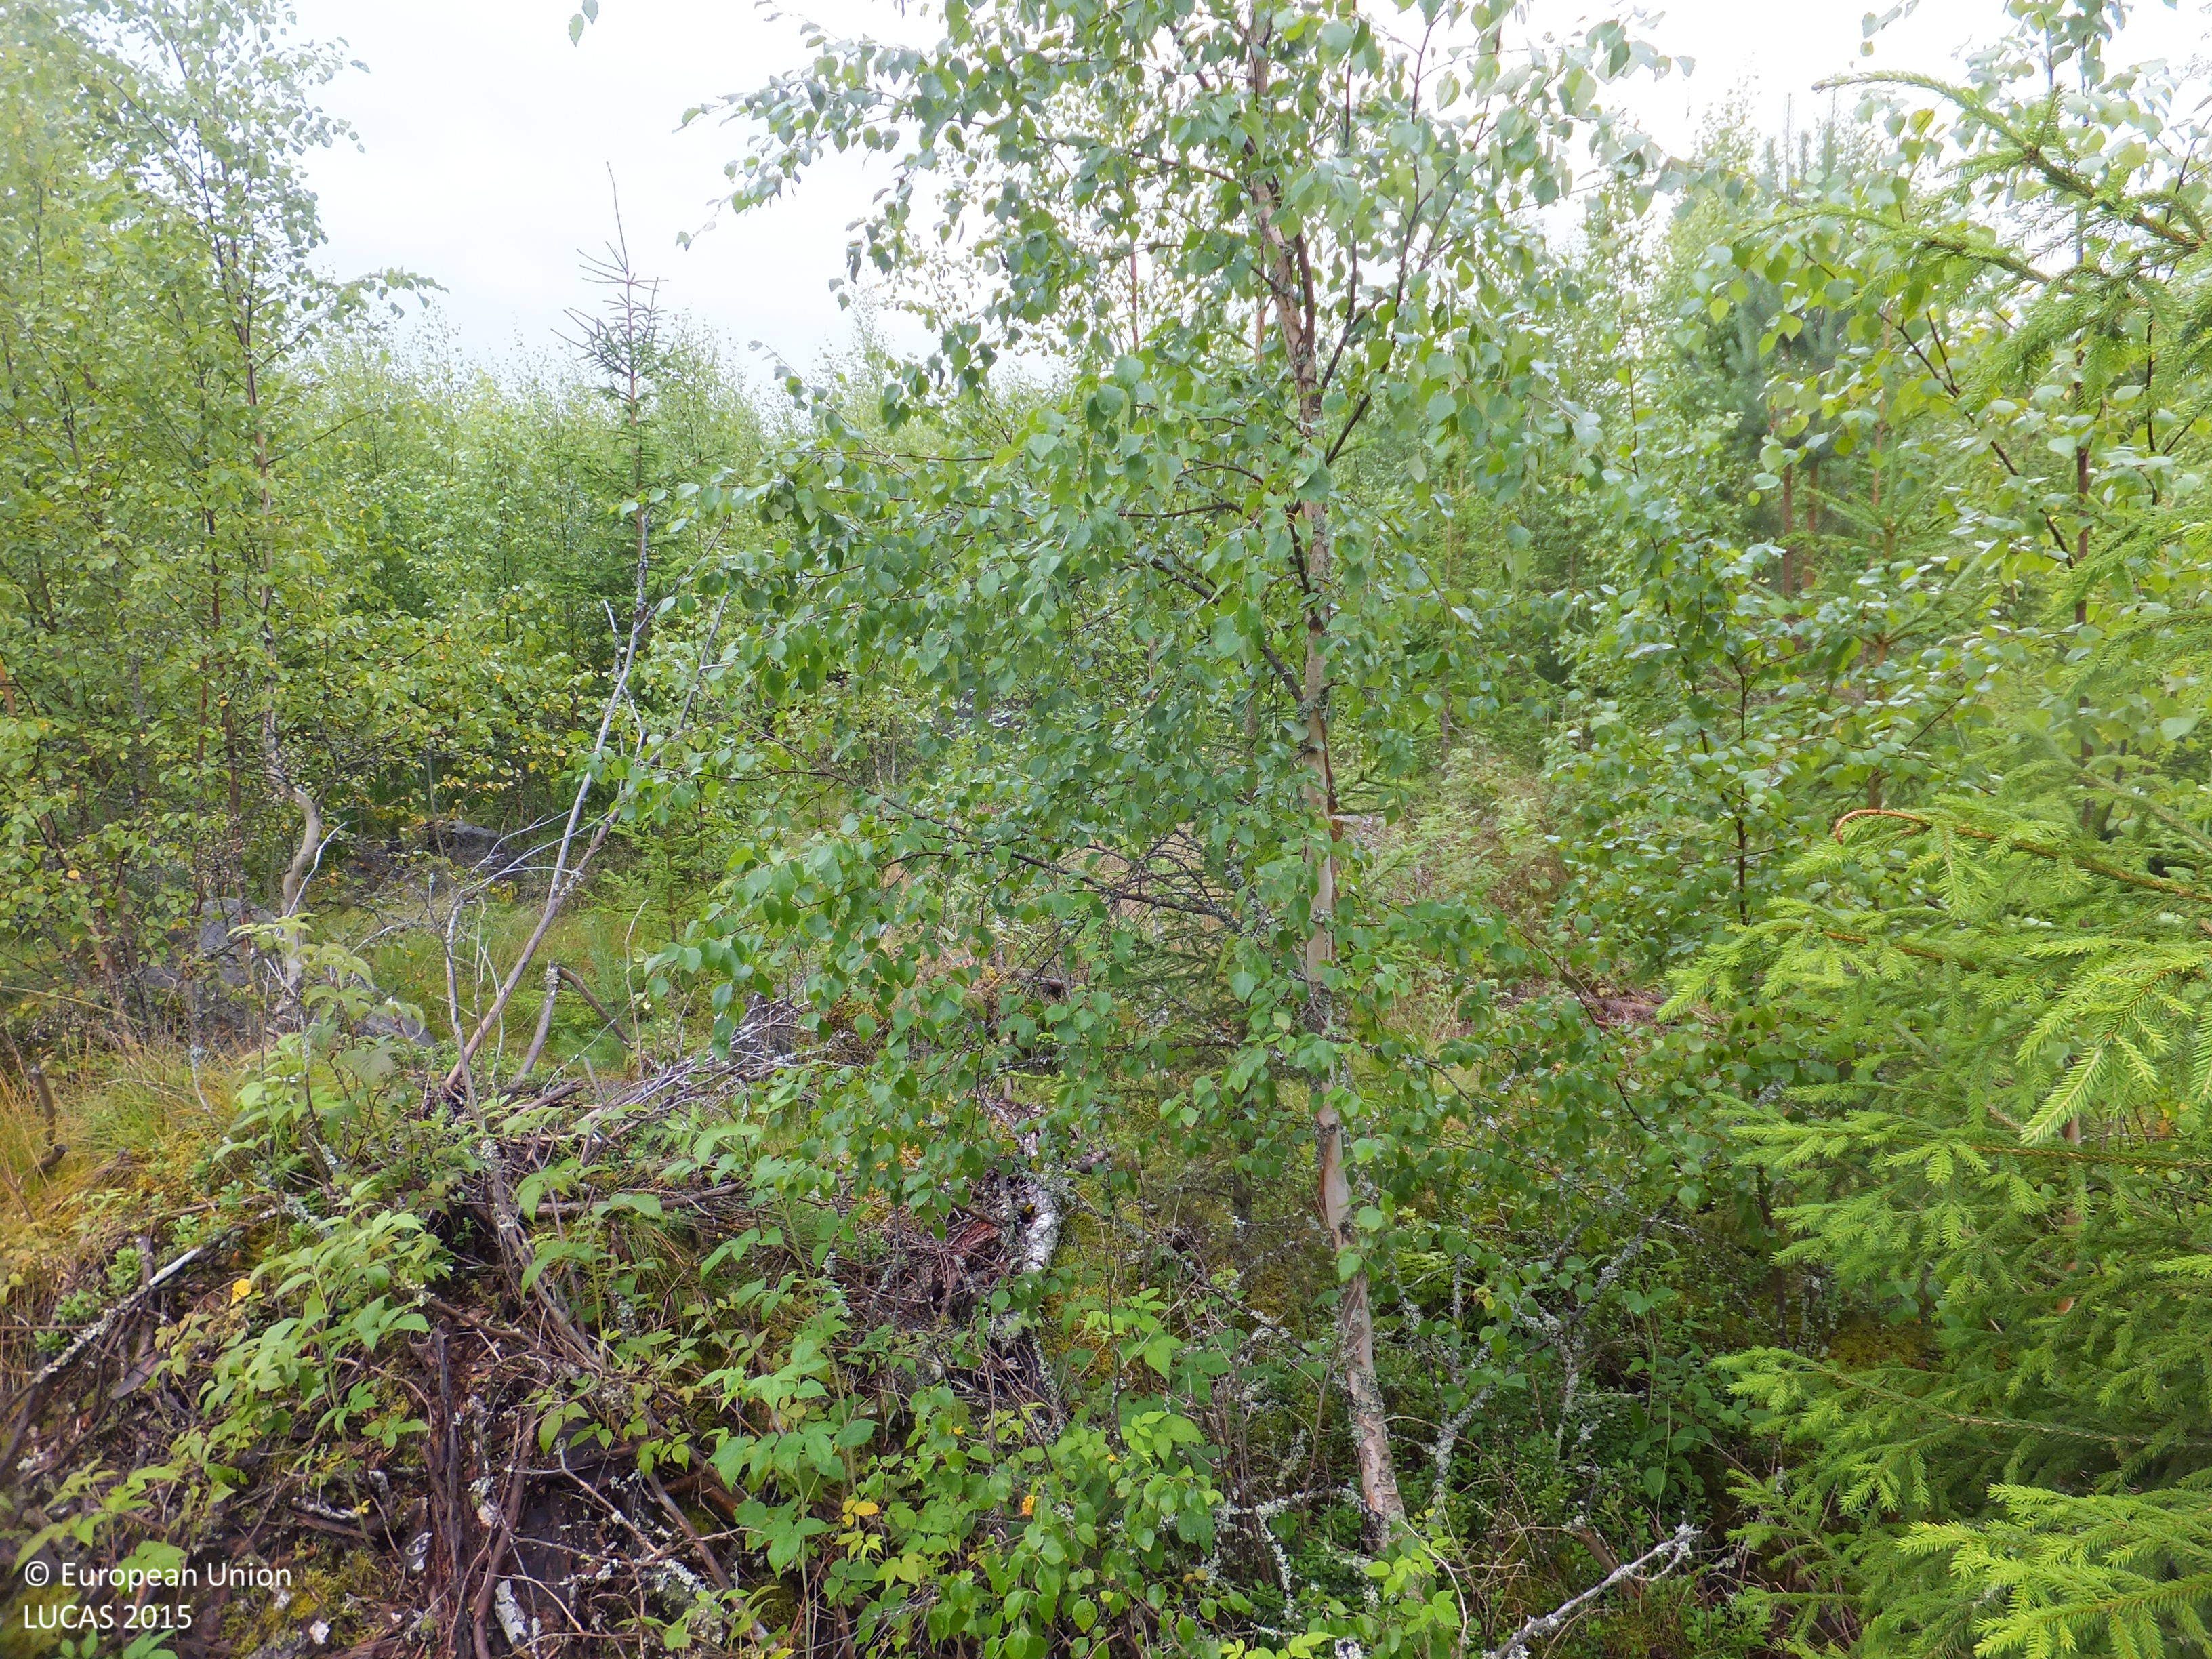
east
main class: Woodland
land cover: Spruce dominated mixed woodland
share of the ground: 10 - 25 %
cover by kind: shrubs 30 %, herbaceous plants 20 %, lichens and mosses 20 %, coniferous forest trees 10 %, broadleaved forest trees 10 %, consolidated bare surface 10 %
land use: Forestry
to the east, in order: Spruce dominated mixed woodland; Broadleaved woodland; Spruce dominated mixed woodland; Pine dominated mixed woodland
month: July
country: FI
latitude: 63.0324
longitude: 21.9231
